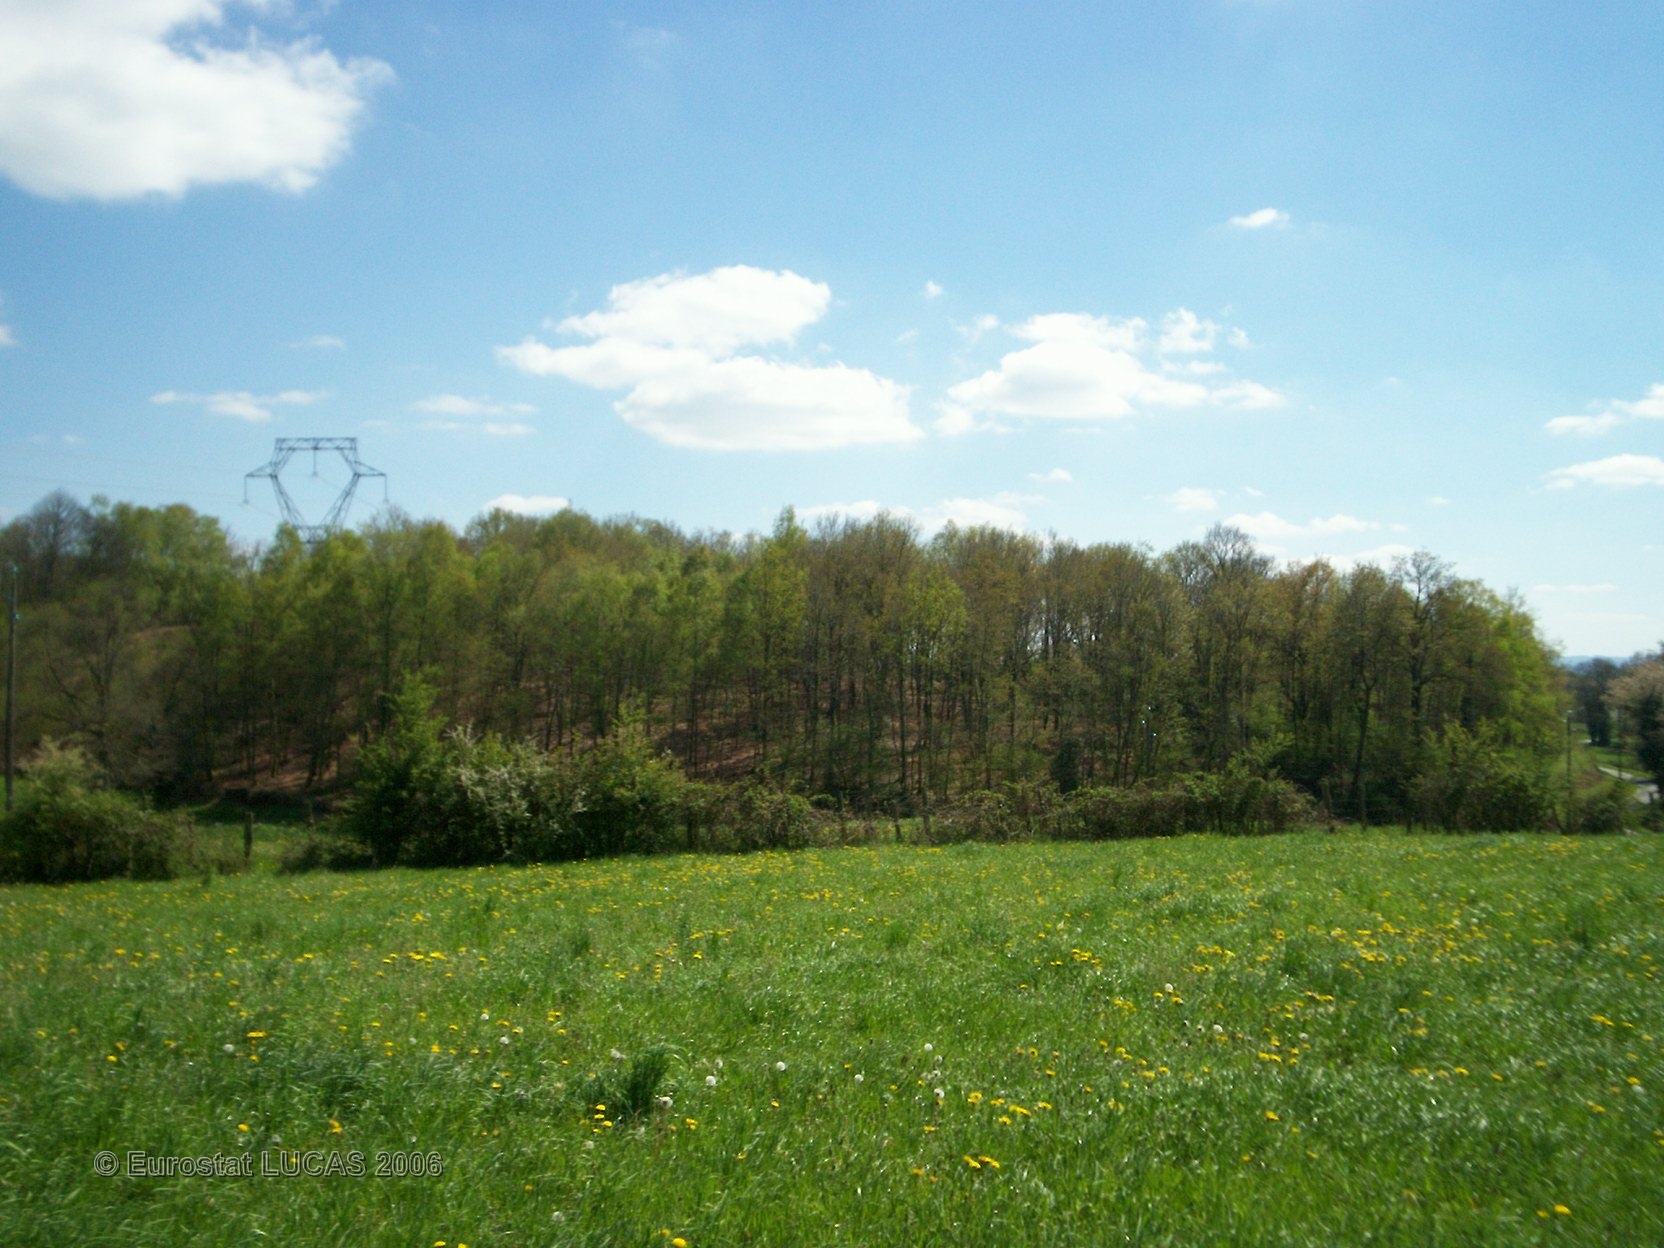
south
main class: Grassland
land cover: Grassland without tree/shrub cover
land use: Agriculture (excluding fallow land and kitchen gardens)
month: April
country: FR
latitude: 46.2239
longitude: 1.6553
